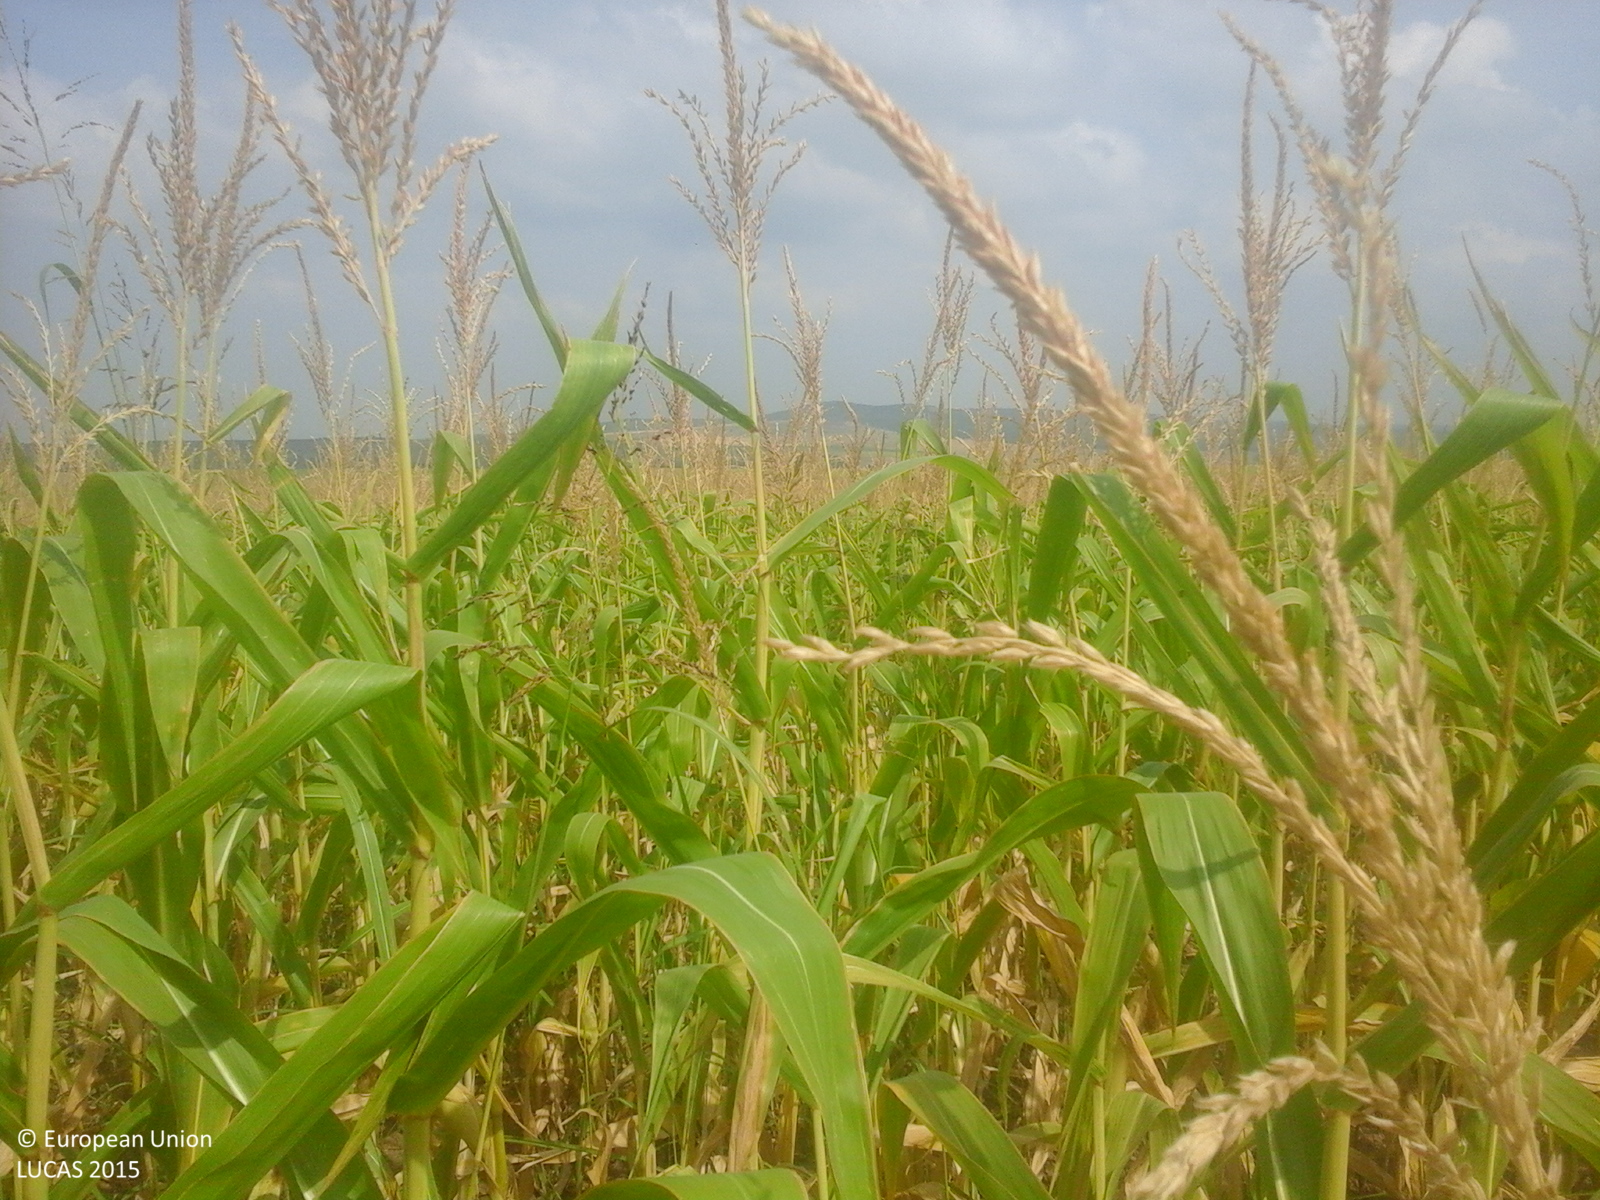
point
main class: Cropland
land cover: Maize
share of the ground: > 75 %
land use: Agriculture (excluding fallow land and kitchen gardens)
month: July
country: RO
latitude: 45.2604
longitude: 28.2579
